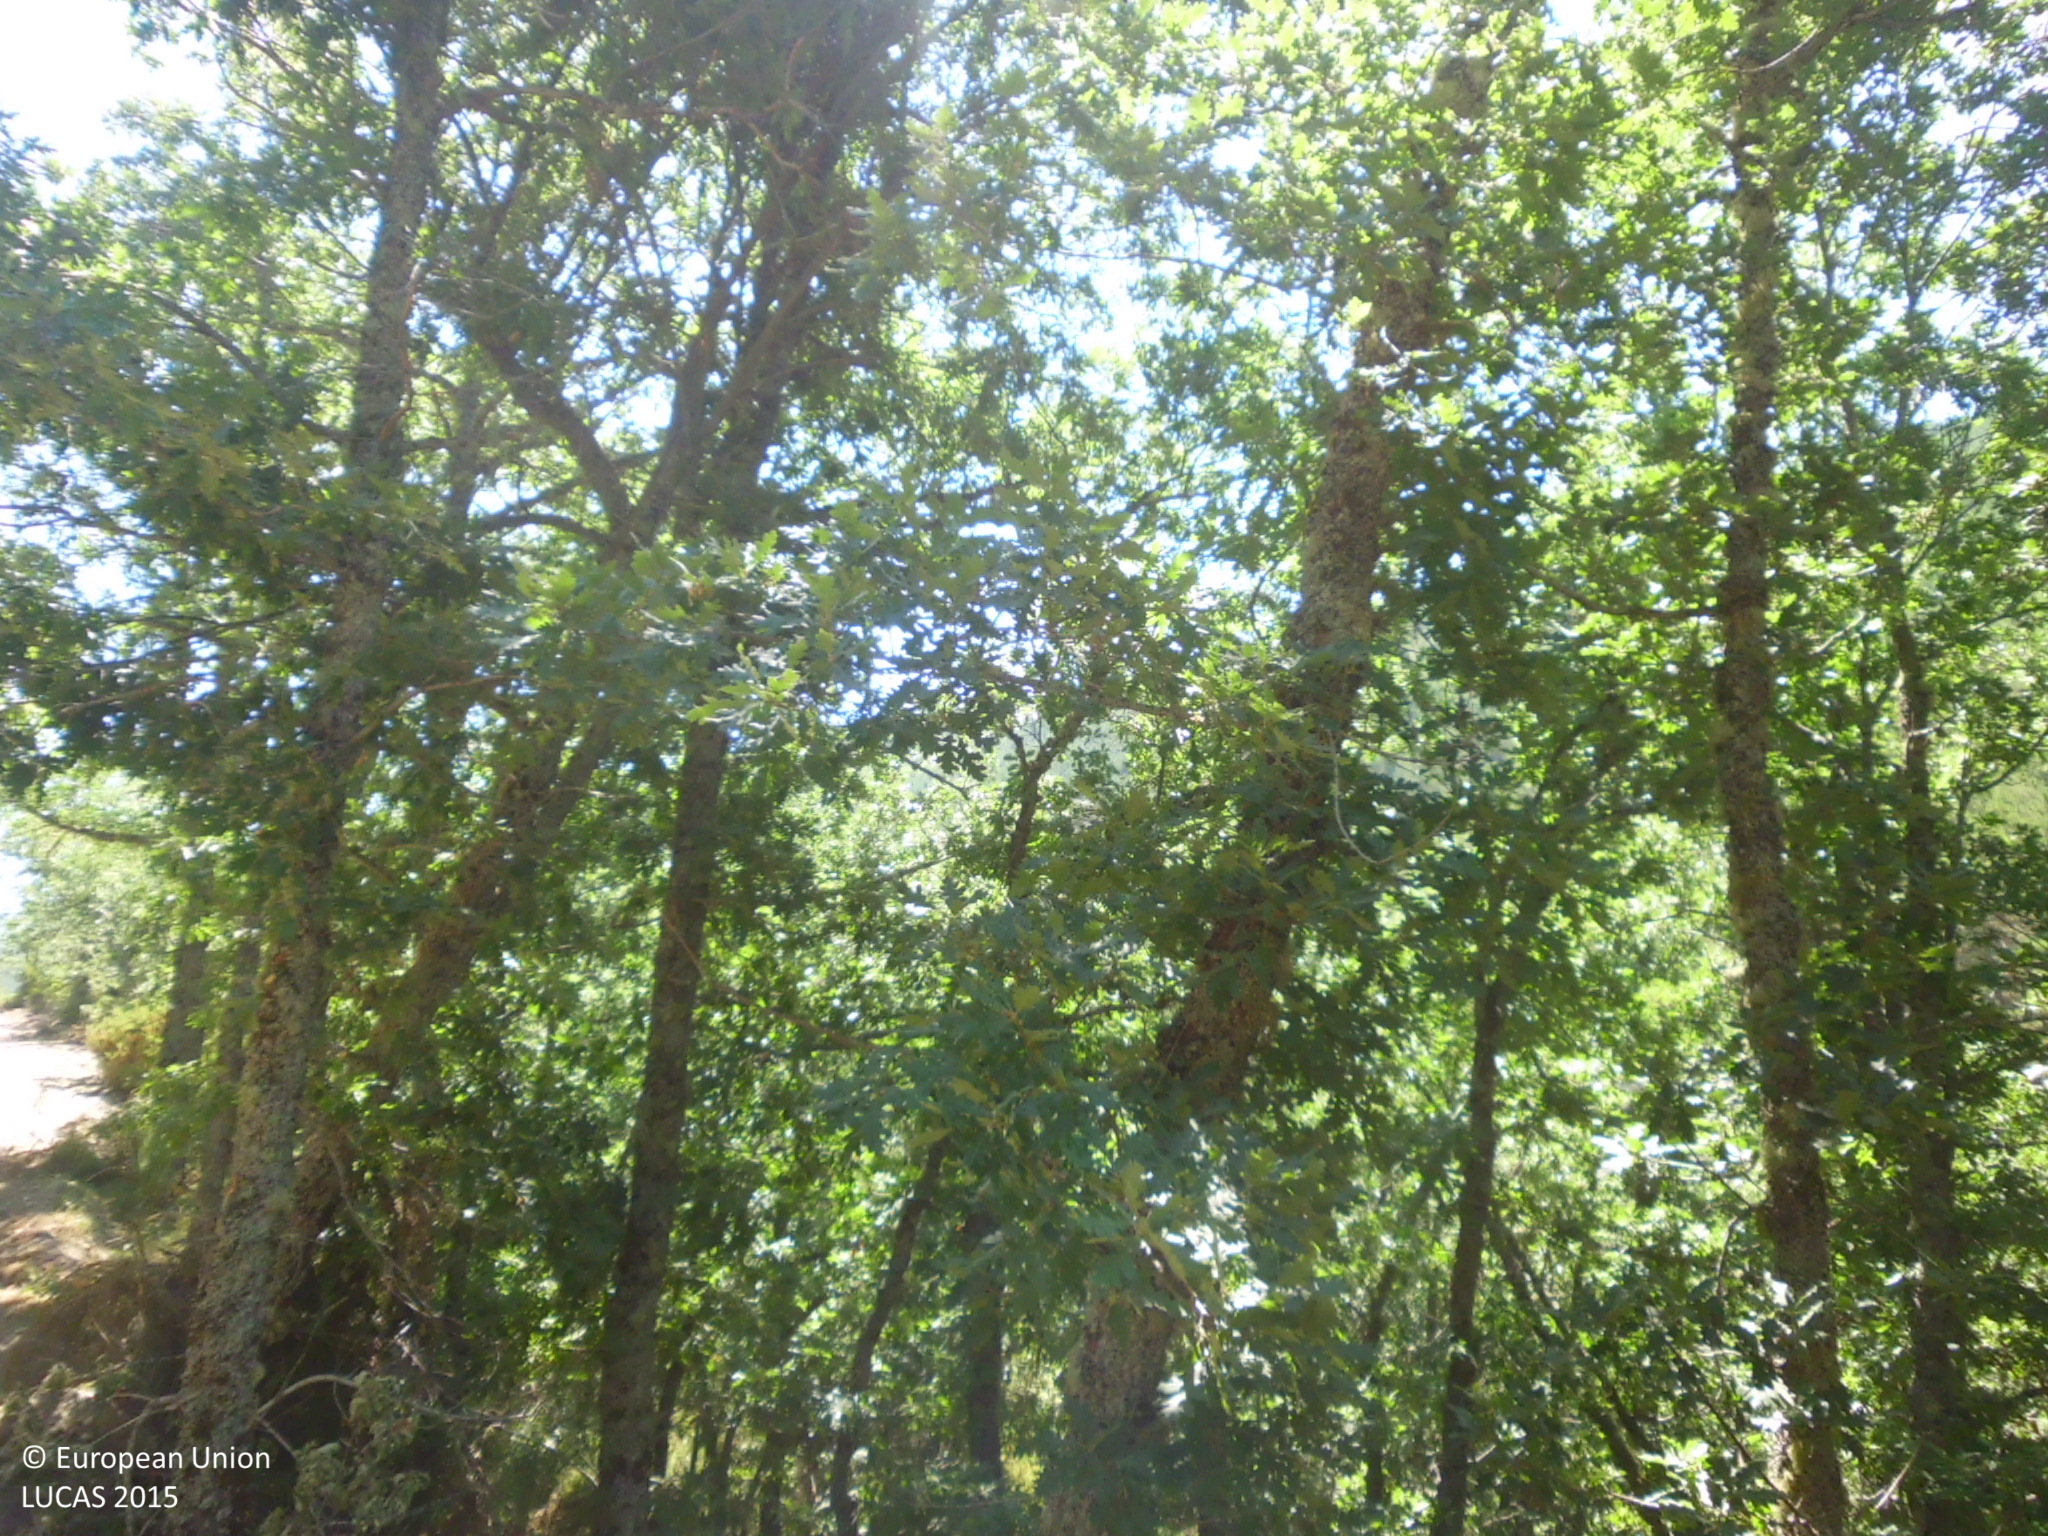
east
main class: Woodland
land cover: Broadleaved woodland
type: acidophilous oak and oak-birch forest
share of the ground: > 75 %
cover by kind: broadleaved forest trees 90 %, shrubs 10 %
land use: Forestry
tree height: > 5 m
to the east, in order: Broadleaved woodland
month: July
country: ES
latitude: 42.2604
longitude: -3.2052
